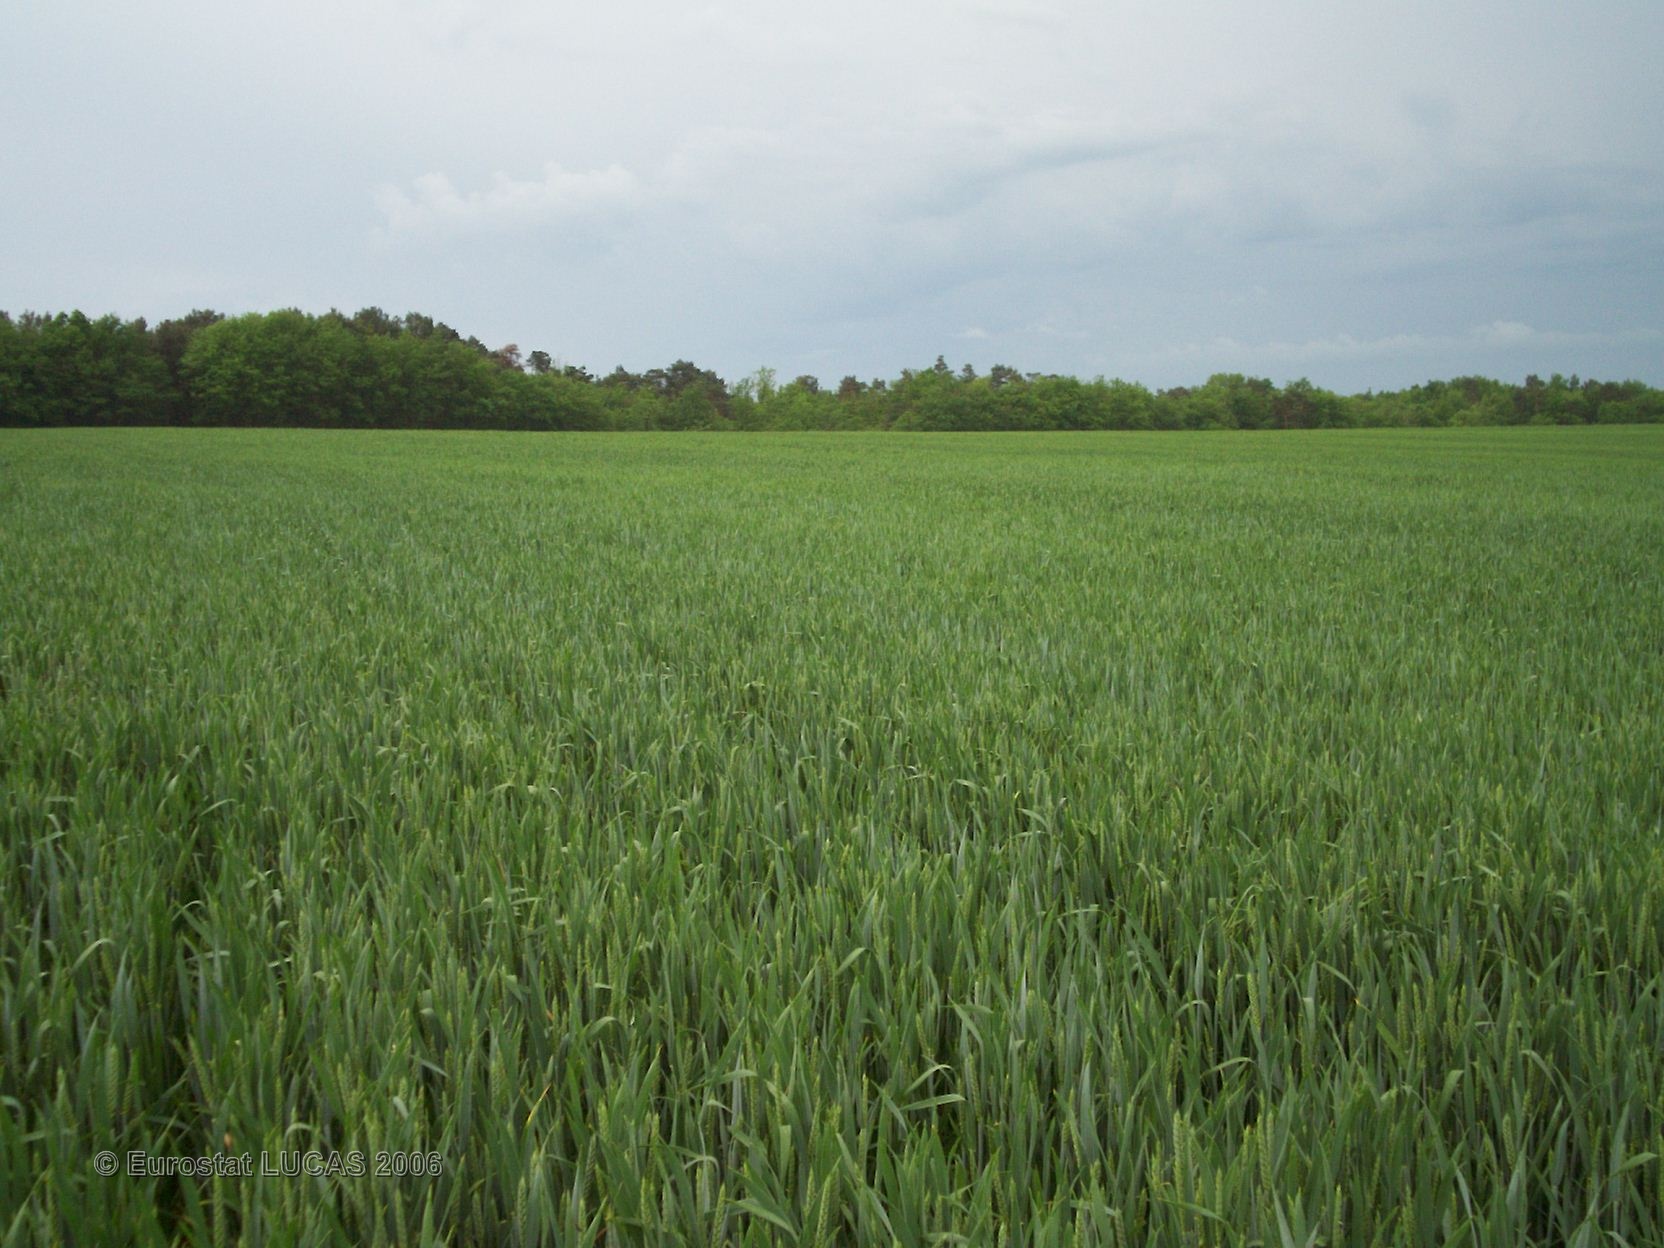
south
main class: Cropland
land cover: Common wheat
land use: Agriculture (excluding fallow land and kitchen gardens)
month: May
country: FR
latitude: 46.8410
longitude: 1.0031
